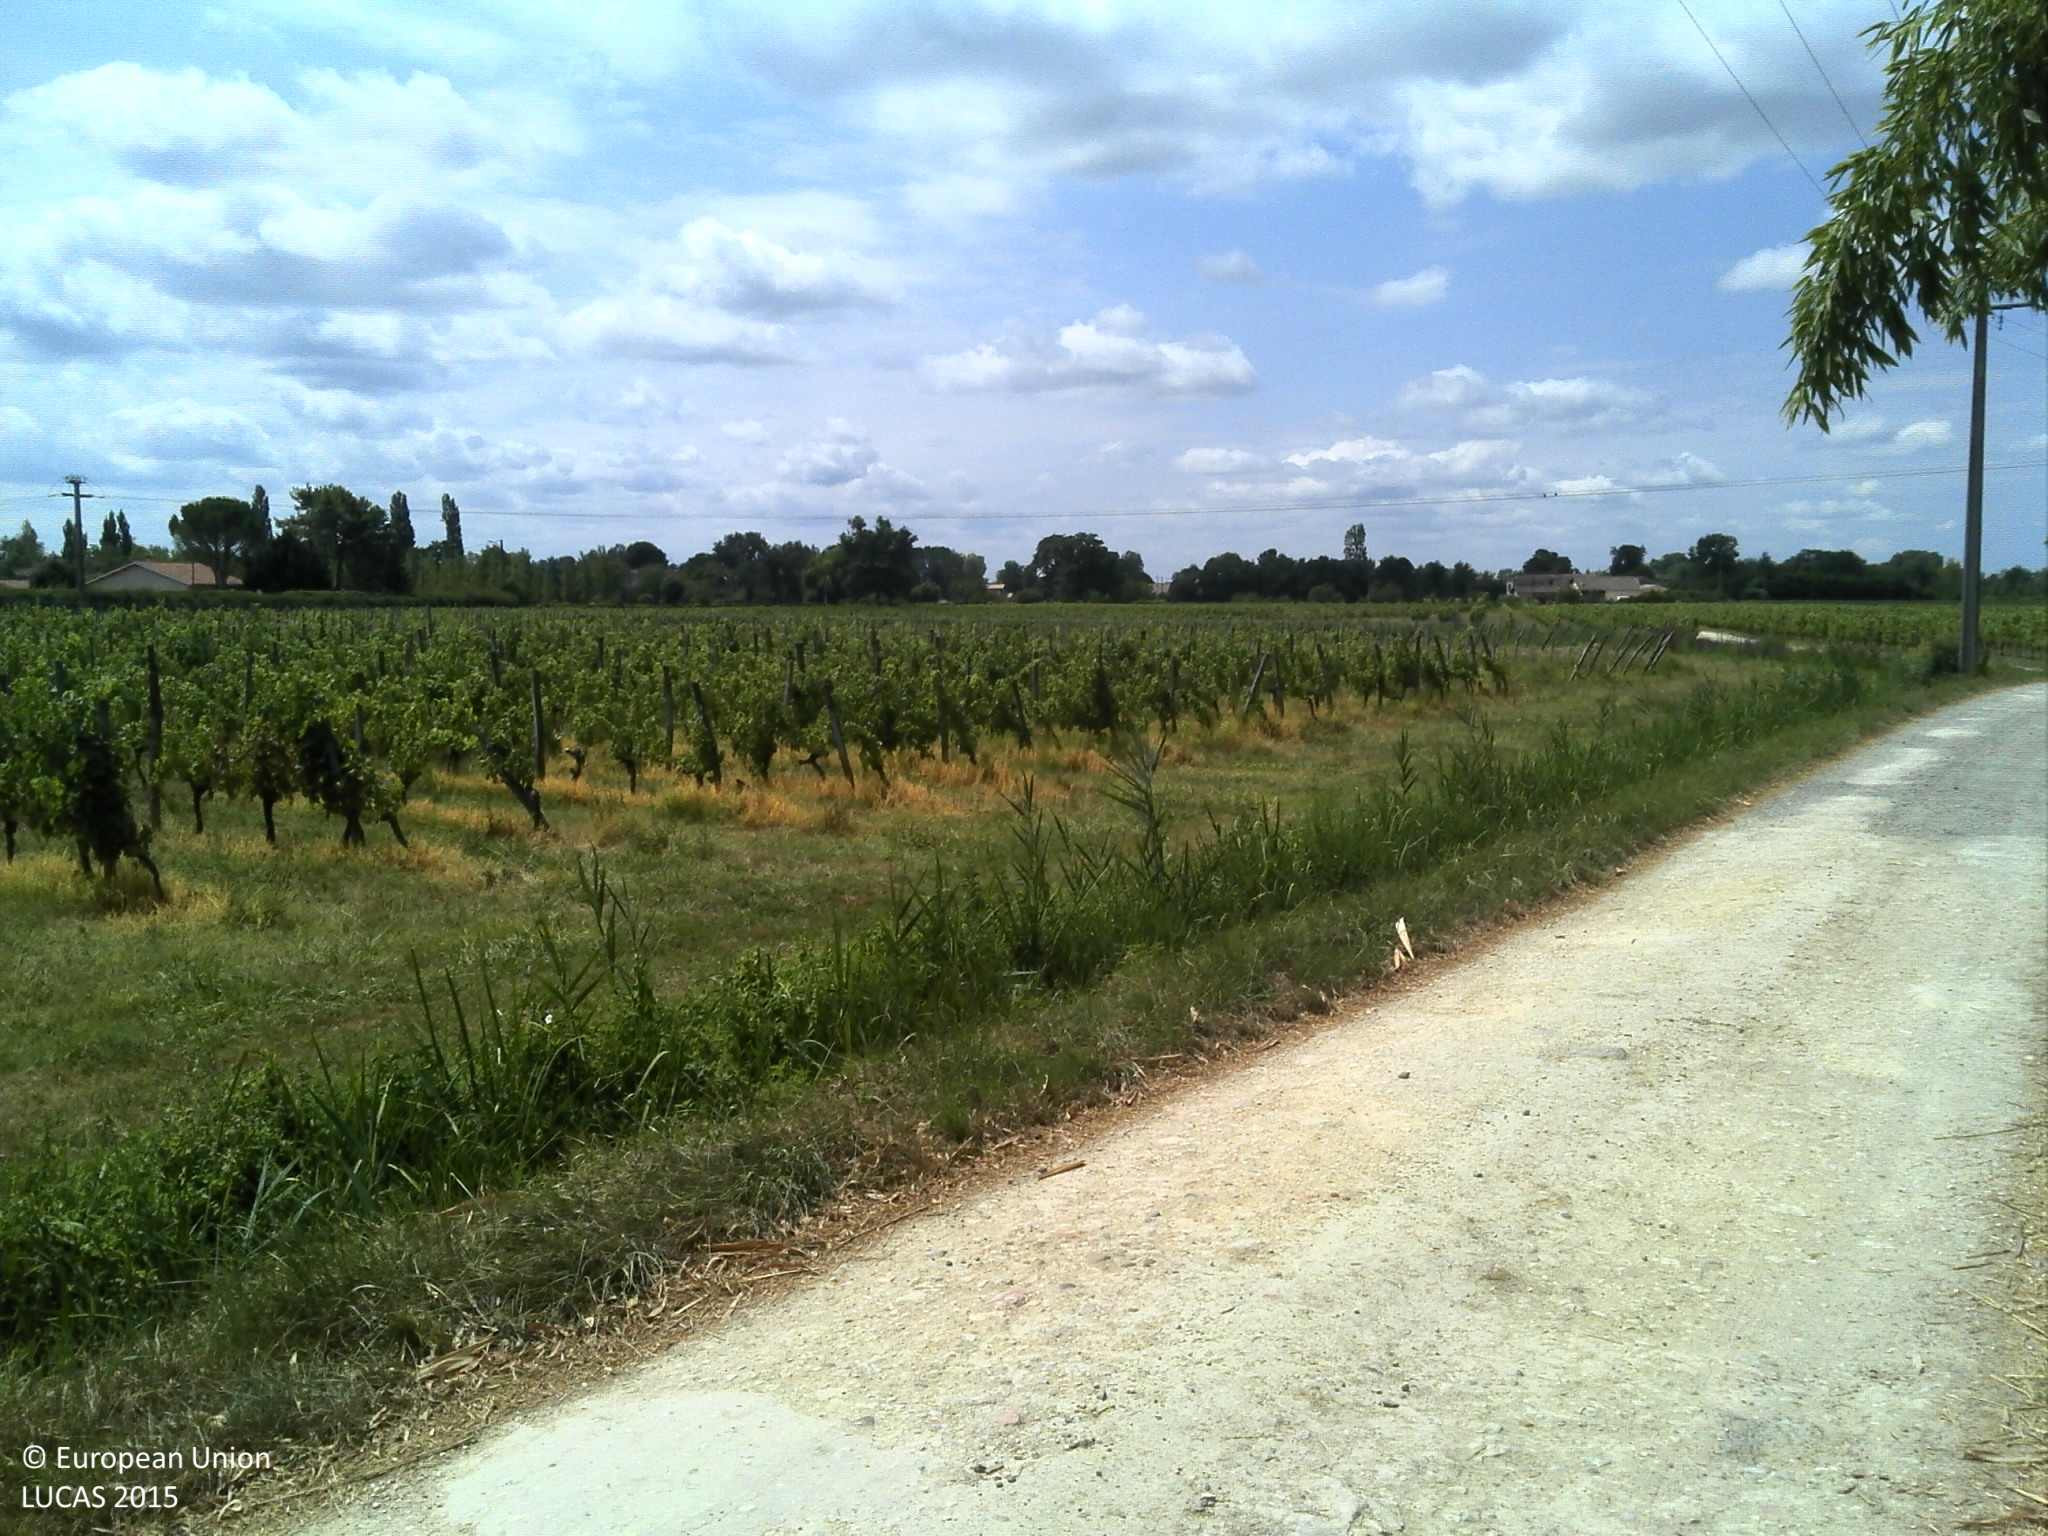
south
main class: Woodland
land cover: Broadleaved woodland
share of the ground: > 75 %
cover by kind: broadleaved forest trees 100 %
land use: Residential
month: July
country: FR
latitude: 44.7445
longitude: -0.4873
